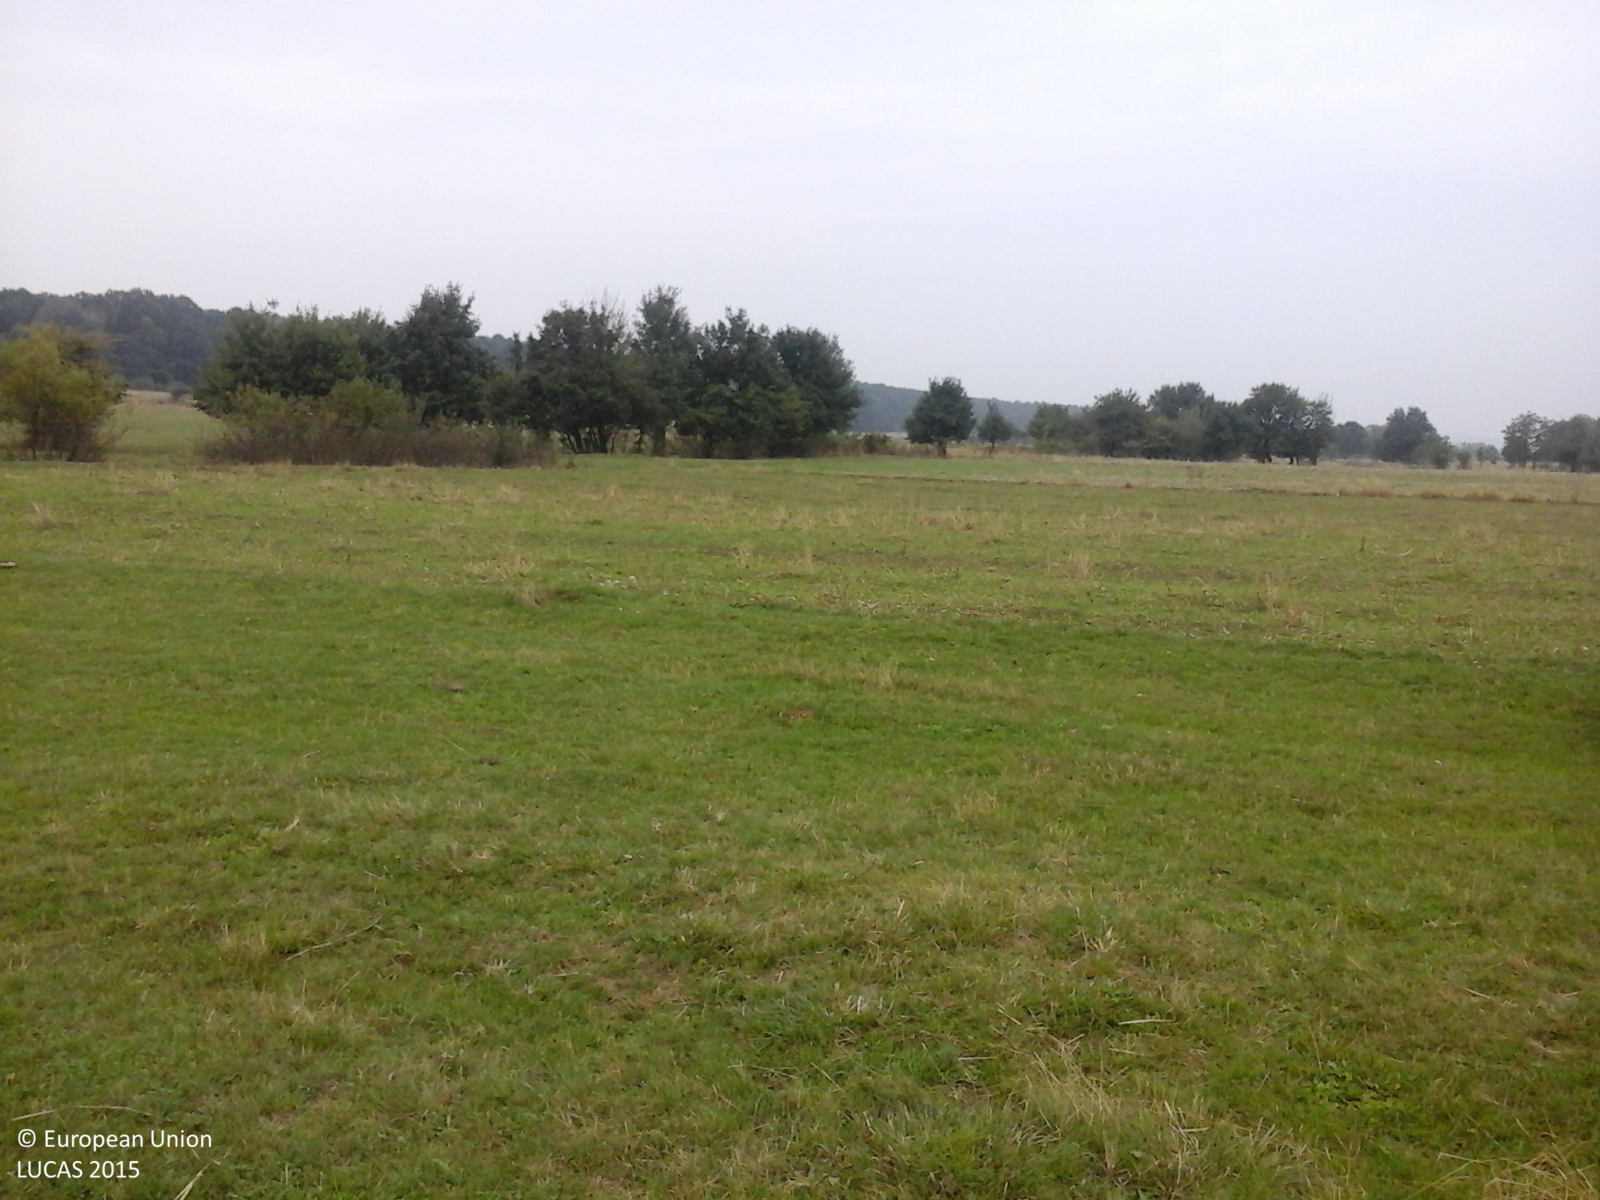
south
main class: Grassland
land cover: Grassland without tree/shrub cover
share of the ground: > 75 %
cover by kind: herbaceous plants 100 %
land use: Agriculture (excluding fallow land and kitchen gardens)
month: September
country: RO
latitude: 45.1373
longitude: 23.2667
